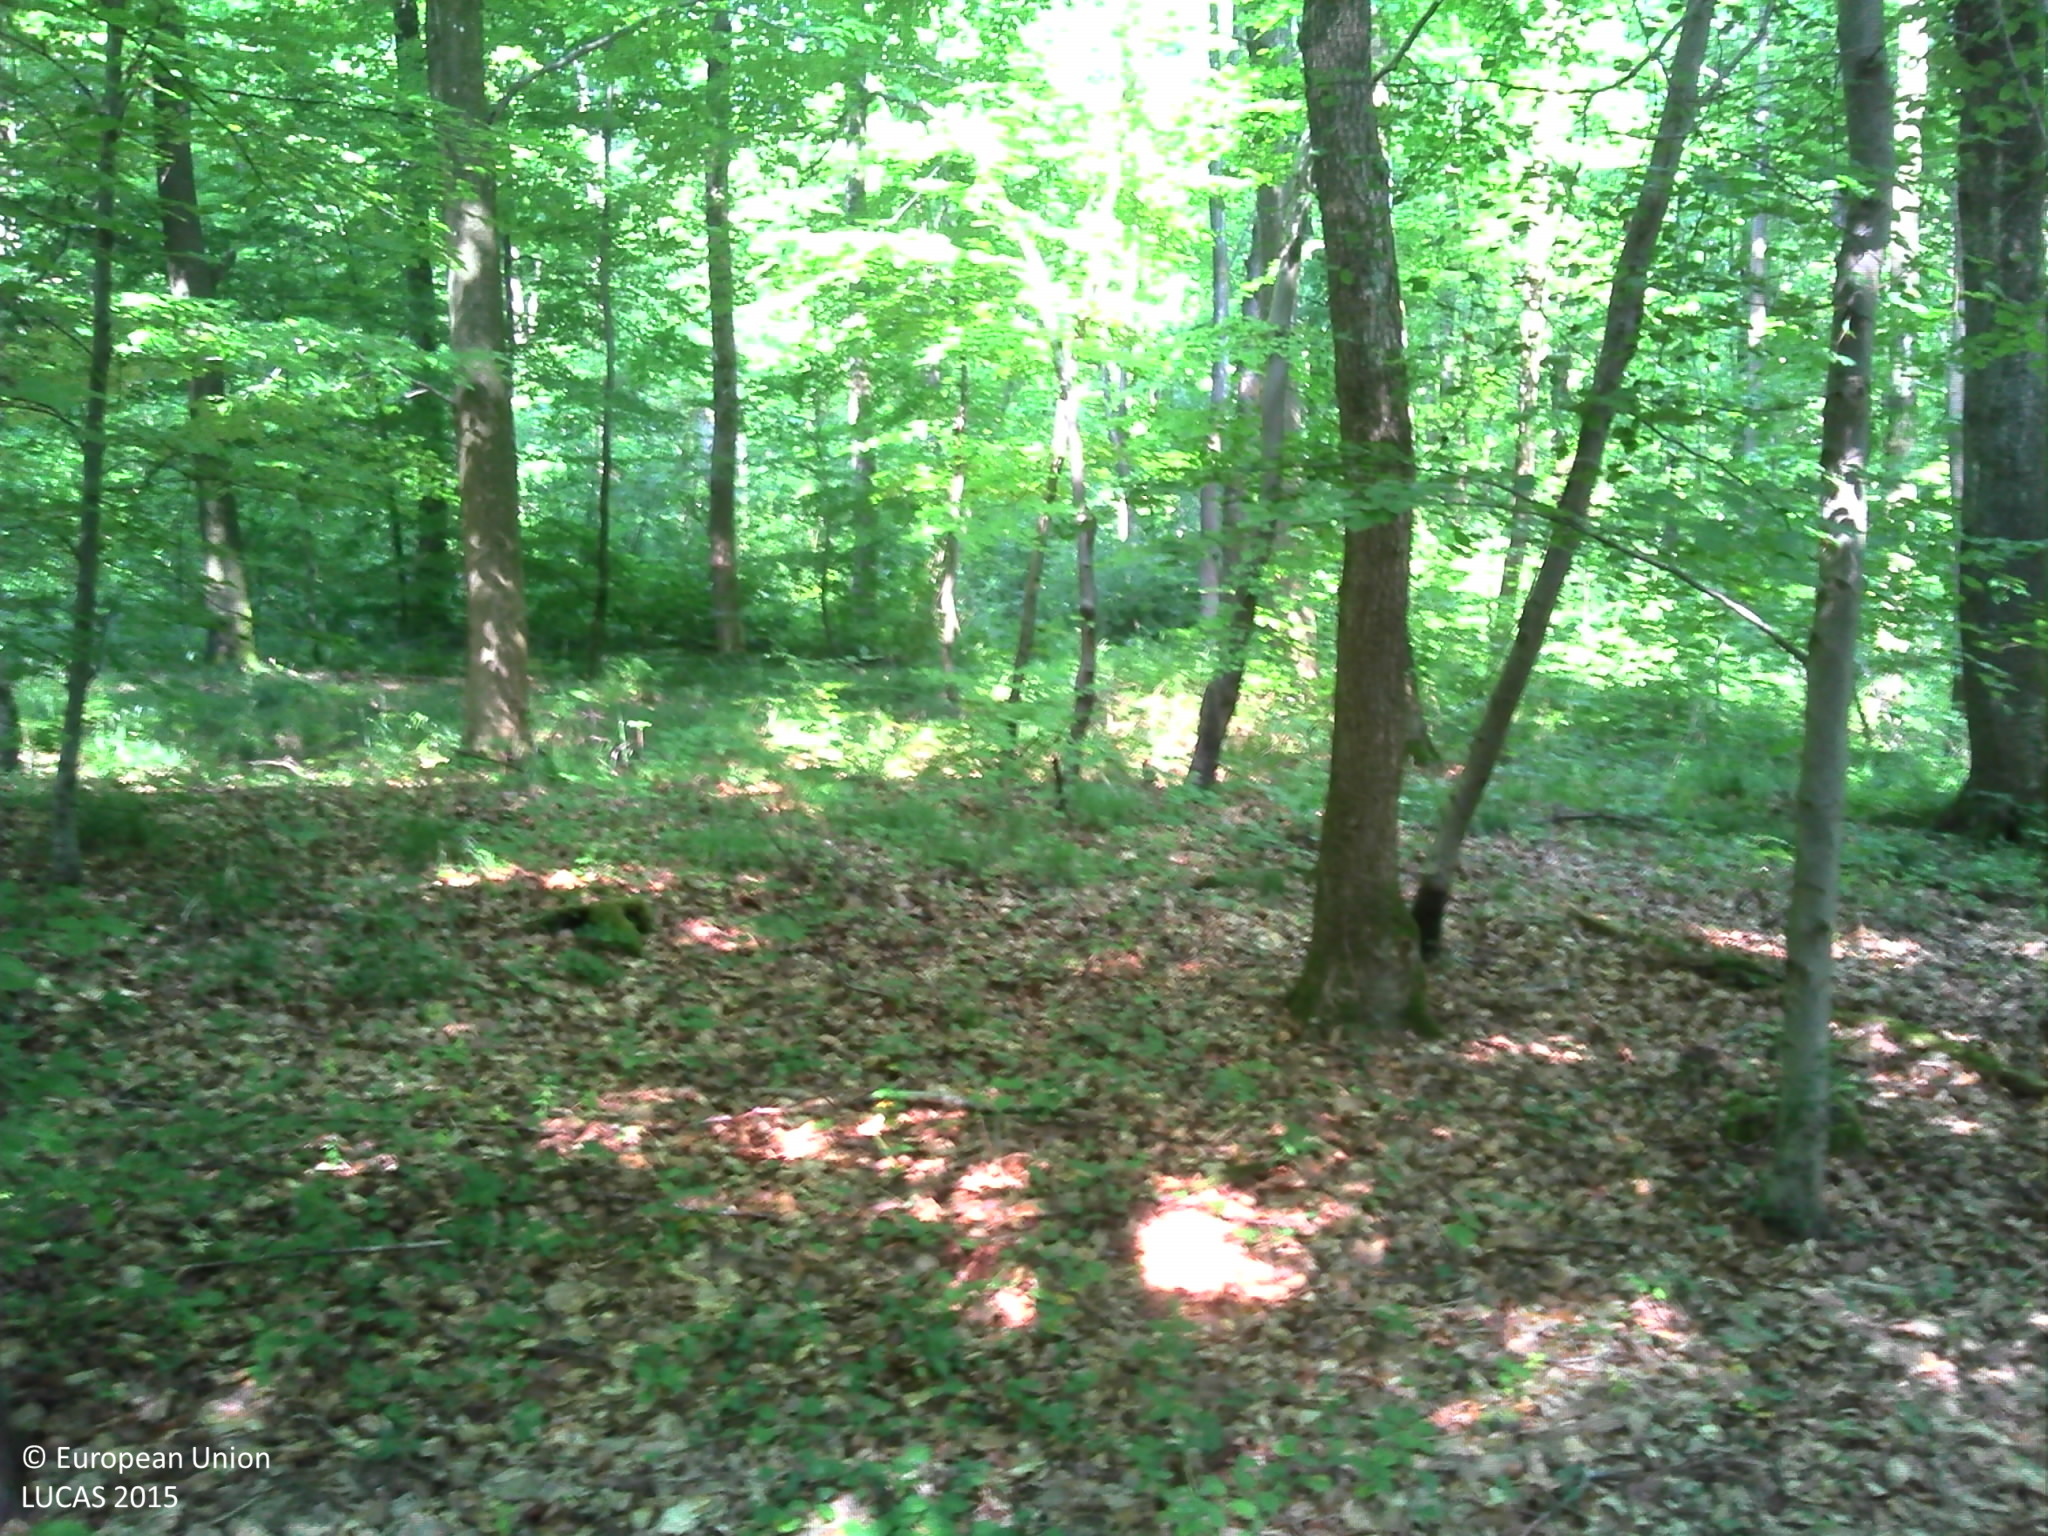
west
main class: Woodland
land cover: Broadleaved woodland
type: acidophilous oak and oak-birch forest
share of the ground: > 75 %
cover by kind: broadleaved forest trees 90 %, herbaceous plants 5 %, lichens and mosses 5 %
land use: Forestry
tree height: > 5 m
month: July
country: FR
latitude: 48.6411
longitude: 6.1050
